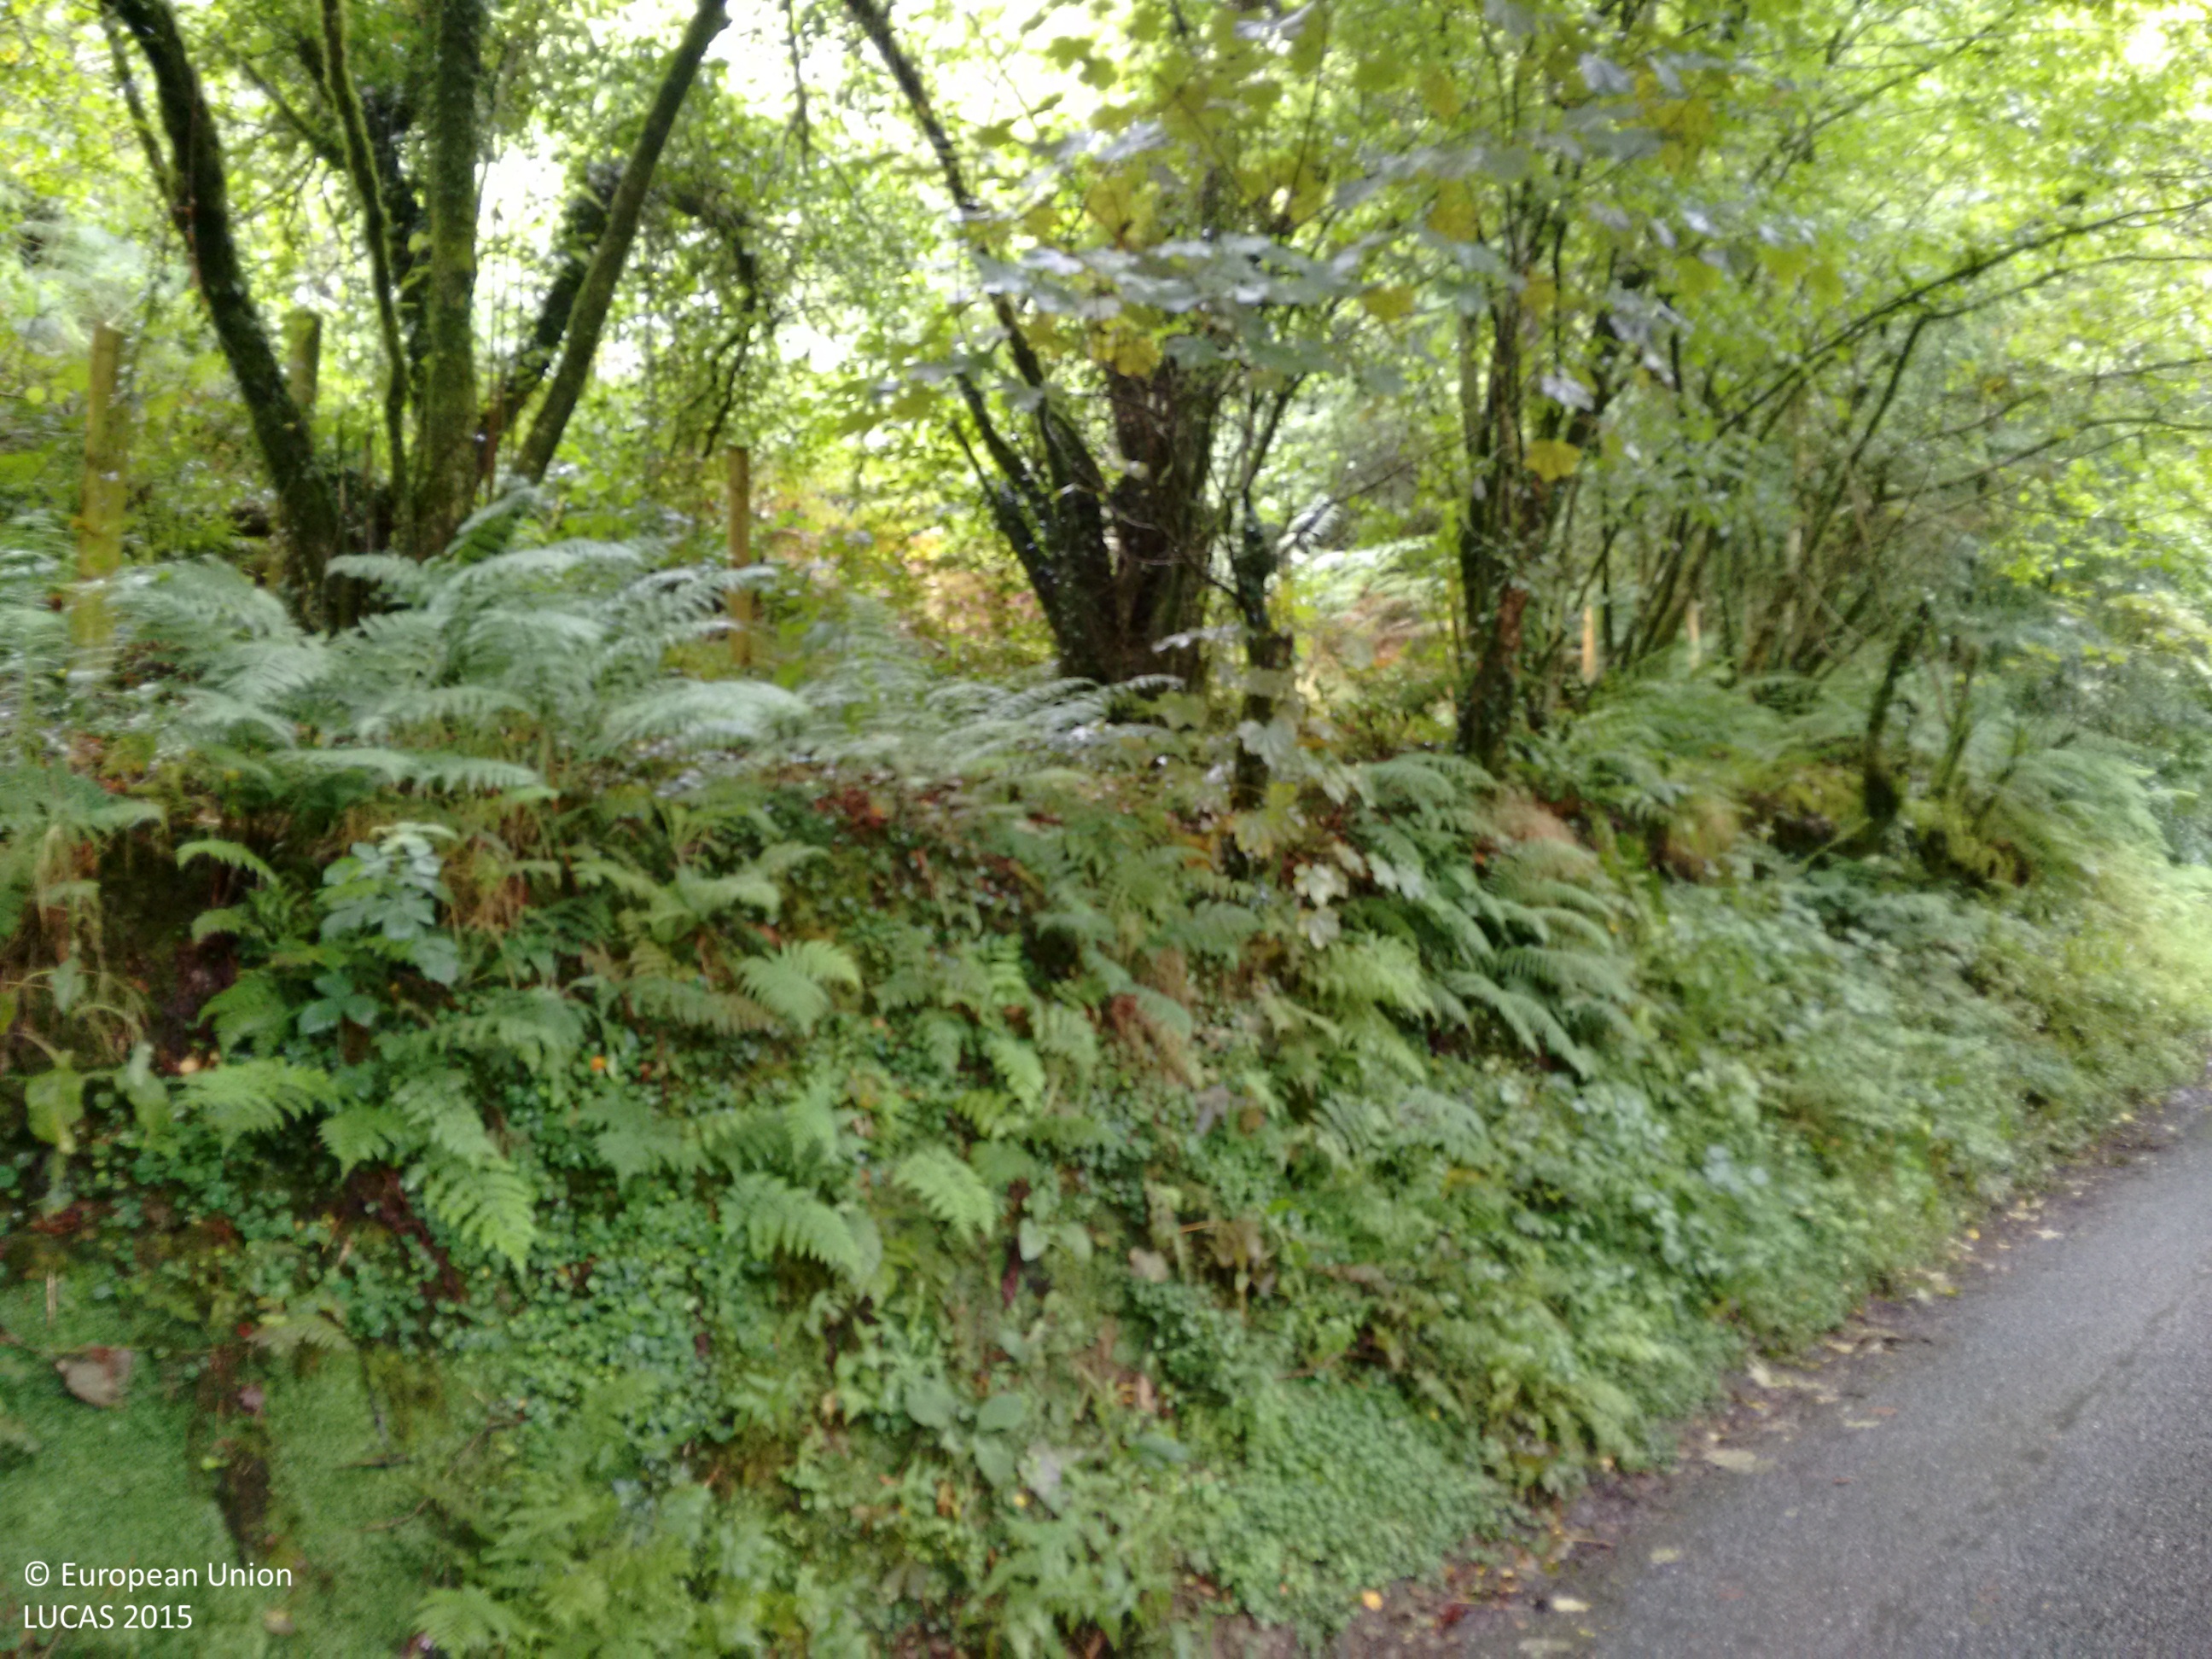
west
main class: Woodland
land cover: Broadleaved woodland
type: mesophytic deciduous forest
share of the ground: > 75 %
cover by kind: broadleaved forest trees 80 %, shrubs 20 %
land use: Semi-natural and natural areas not in use
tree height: > 5 m
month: August
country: GB
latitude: 51.9317
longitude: -4.1023
